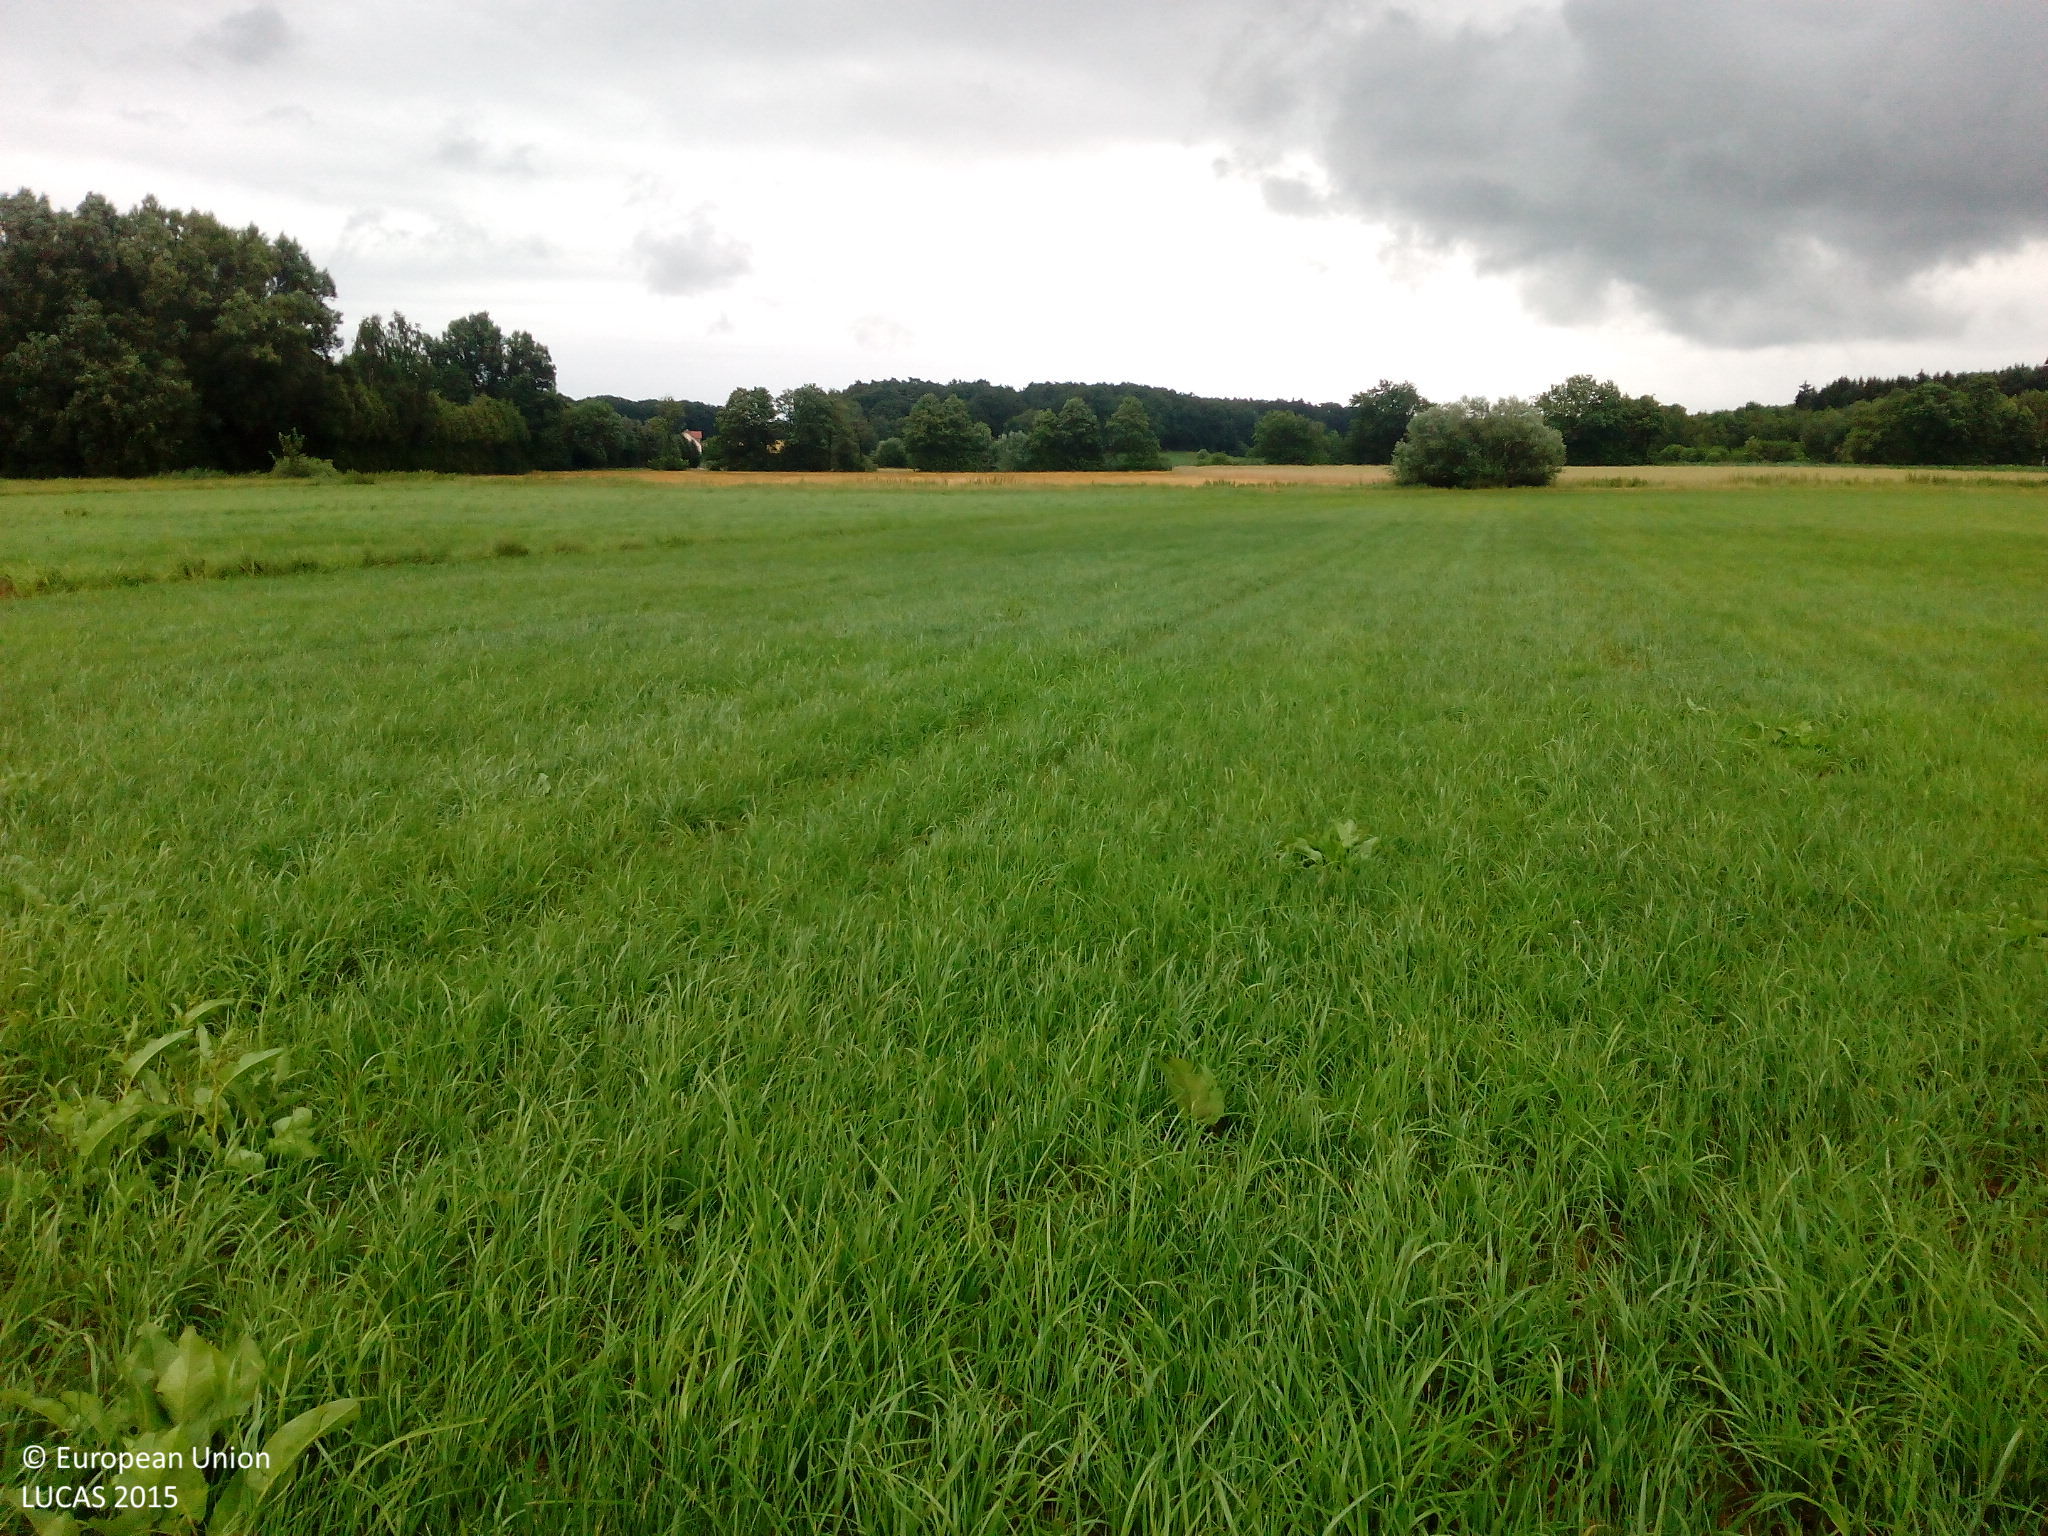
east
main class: Grassland
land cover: Grassland without tree/shrub cover
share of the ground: > 75 %
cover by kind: herbaceous plants 80 %, unconsolidated bare surface 15 %, lichens and mosses 5 %
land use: Agriculture (excluding fallow land and kitchen gardens)
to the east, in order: Grassland without tree/shrub cover; Temporary grasslands; Tracks; Shruby margins; Ditches and canals; Broadleaved woodland; Artificial constructions in urban areas; Other mixed woodland; Rivers and streams; Spruce dominated mixed woodland
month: July
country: DE
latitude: 48.6455
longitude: 11.4787
